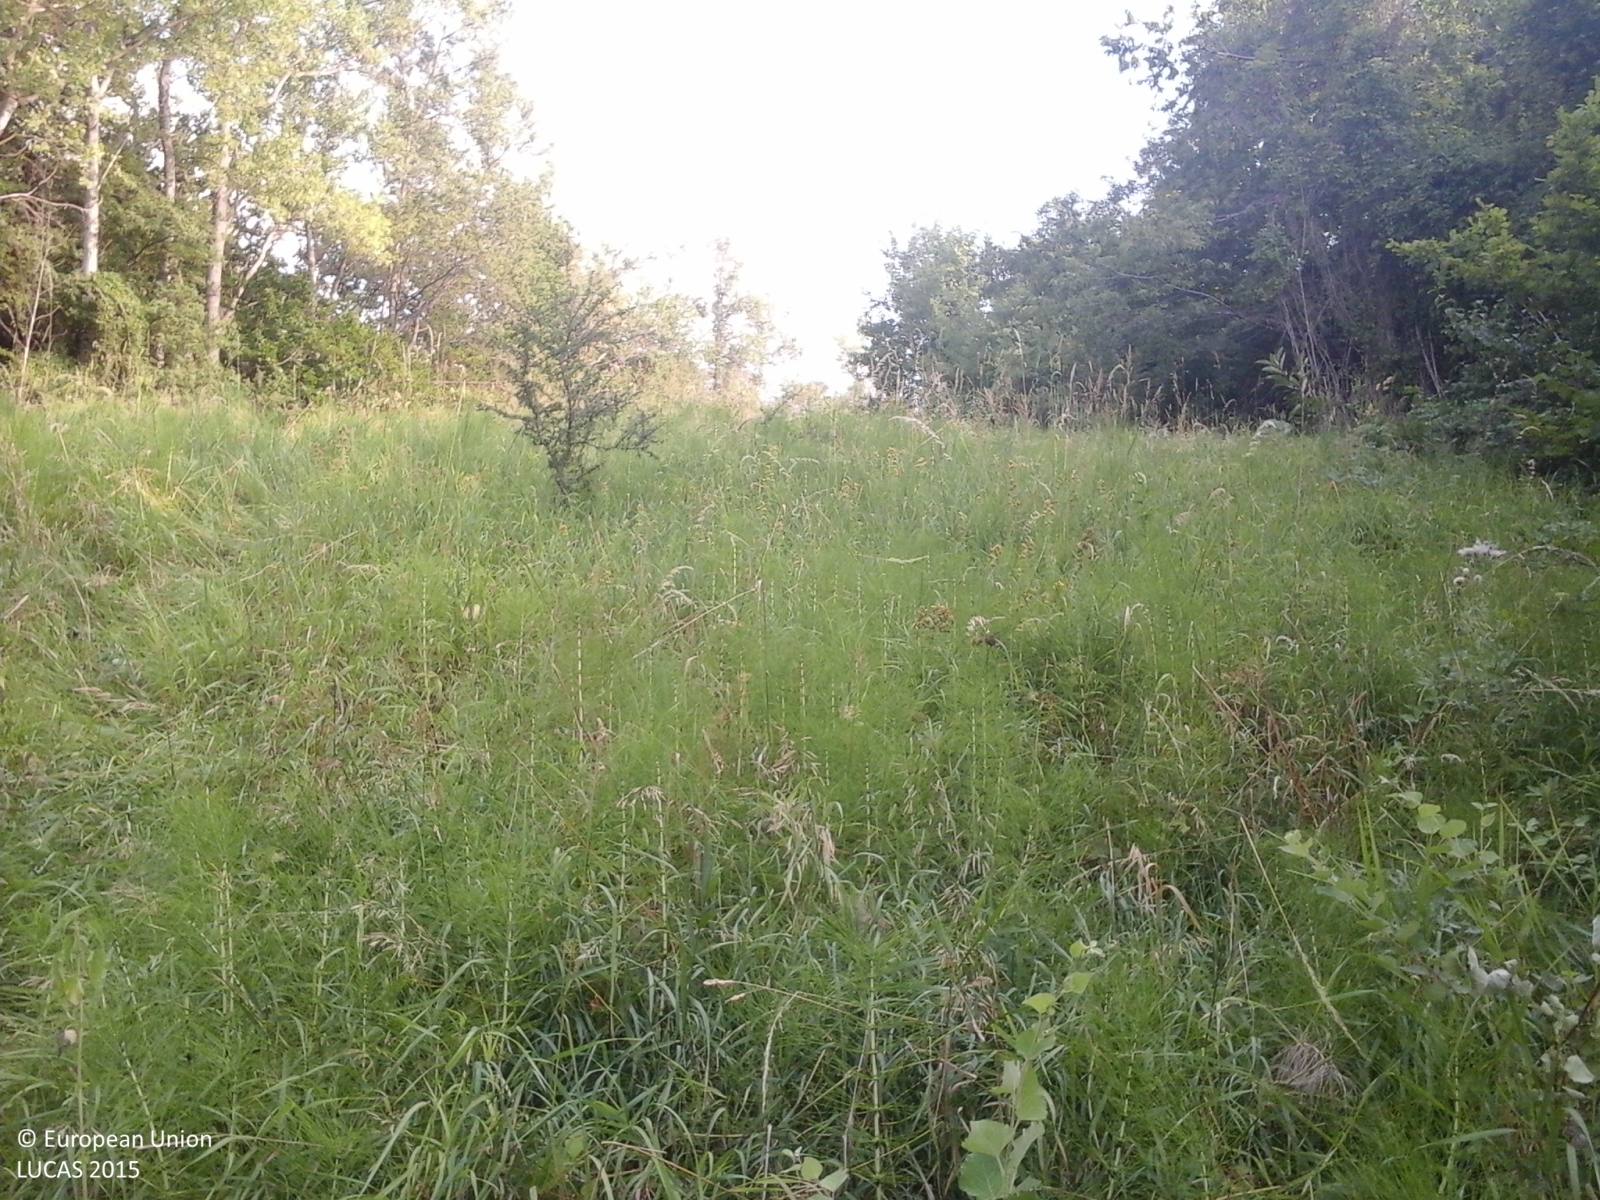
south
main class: Woodland
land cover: Broadleaved woodland
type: thermophilous deciduous forest
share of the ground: > 75 %
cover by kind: broadleaved forest trees 100 %
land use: Forestry
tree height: > 5 m
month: July
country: IT
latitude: 44.3487
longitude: 10.6133
